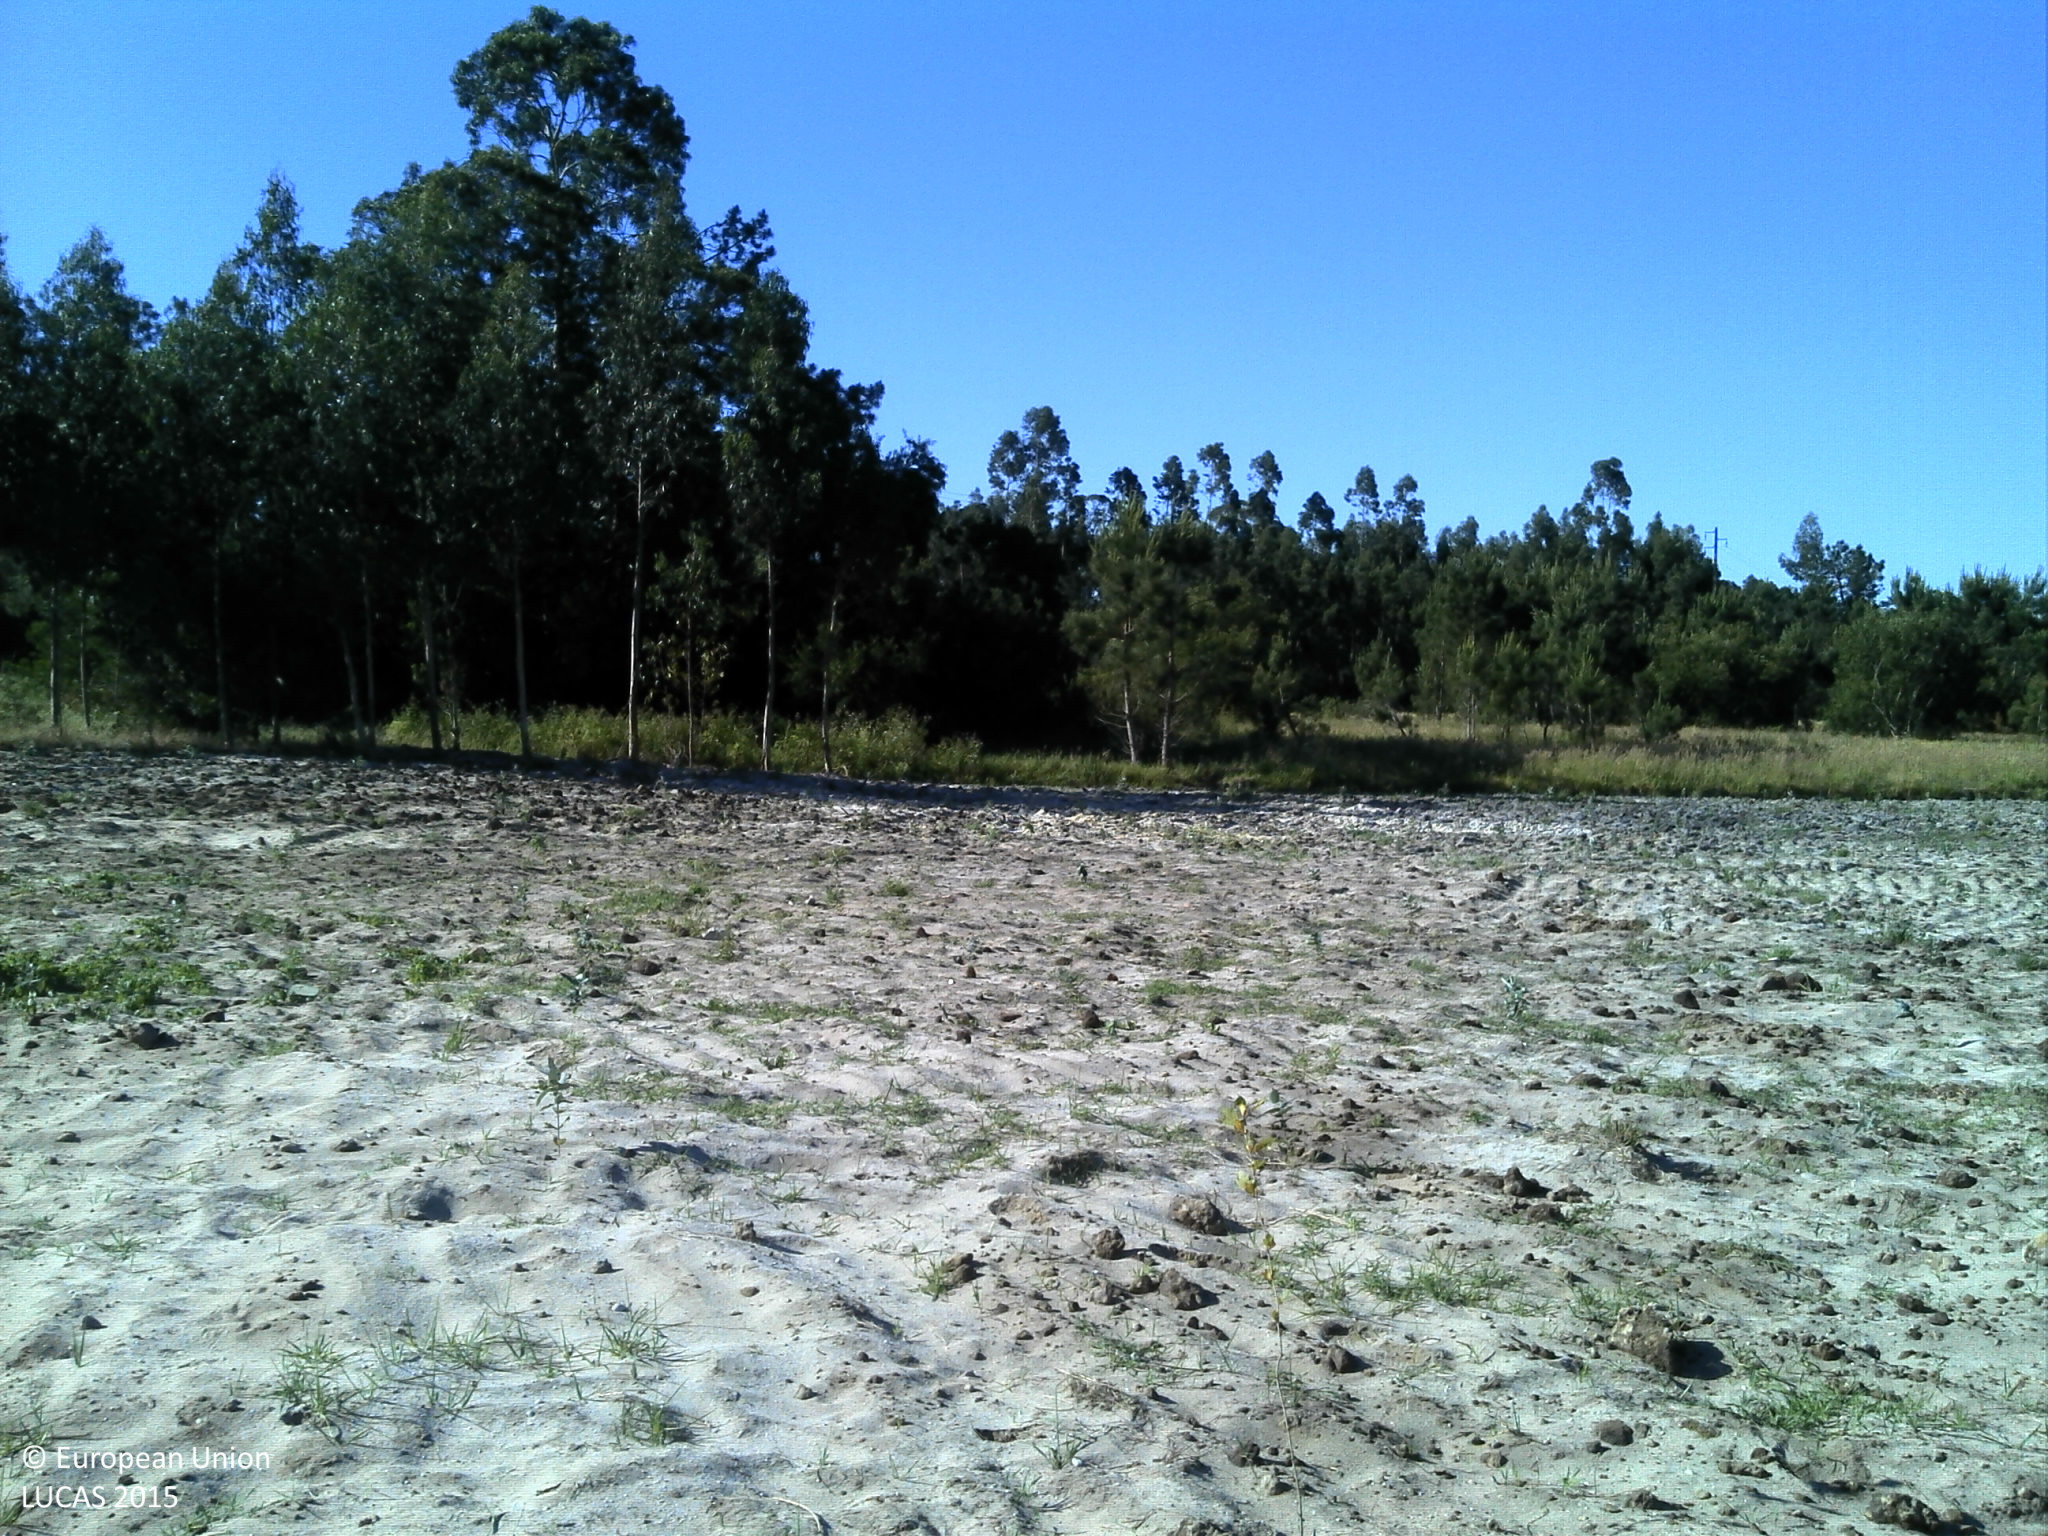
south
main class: Grassland
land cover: Grassland without tree/shrub cover
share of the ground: > 75 %
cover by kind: herbaceous plants 75 %, unconsolidated bare surface 25 %
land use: Agriculture (excluding fallow land and kitchen gardens)
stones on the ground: < 10 %
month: May
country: PT
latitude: 40.4912
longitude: -8.6779
